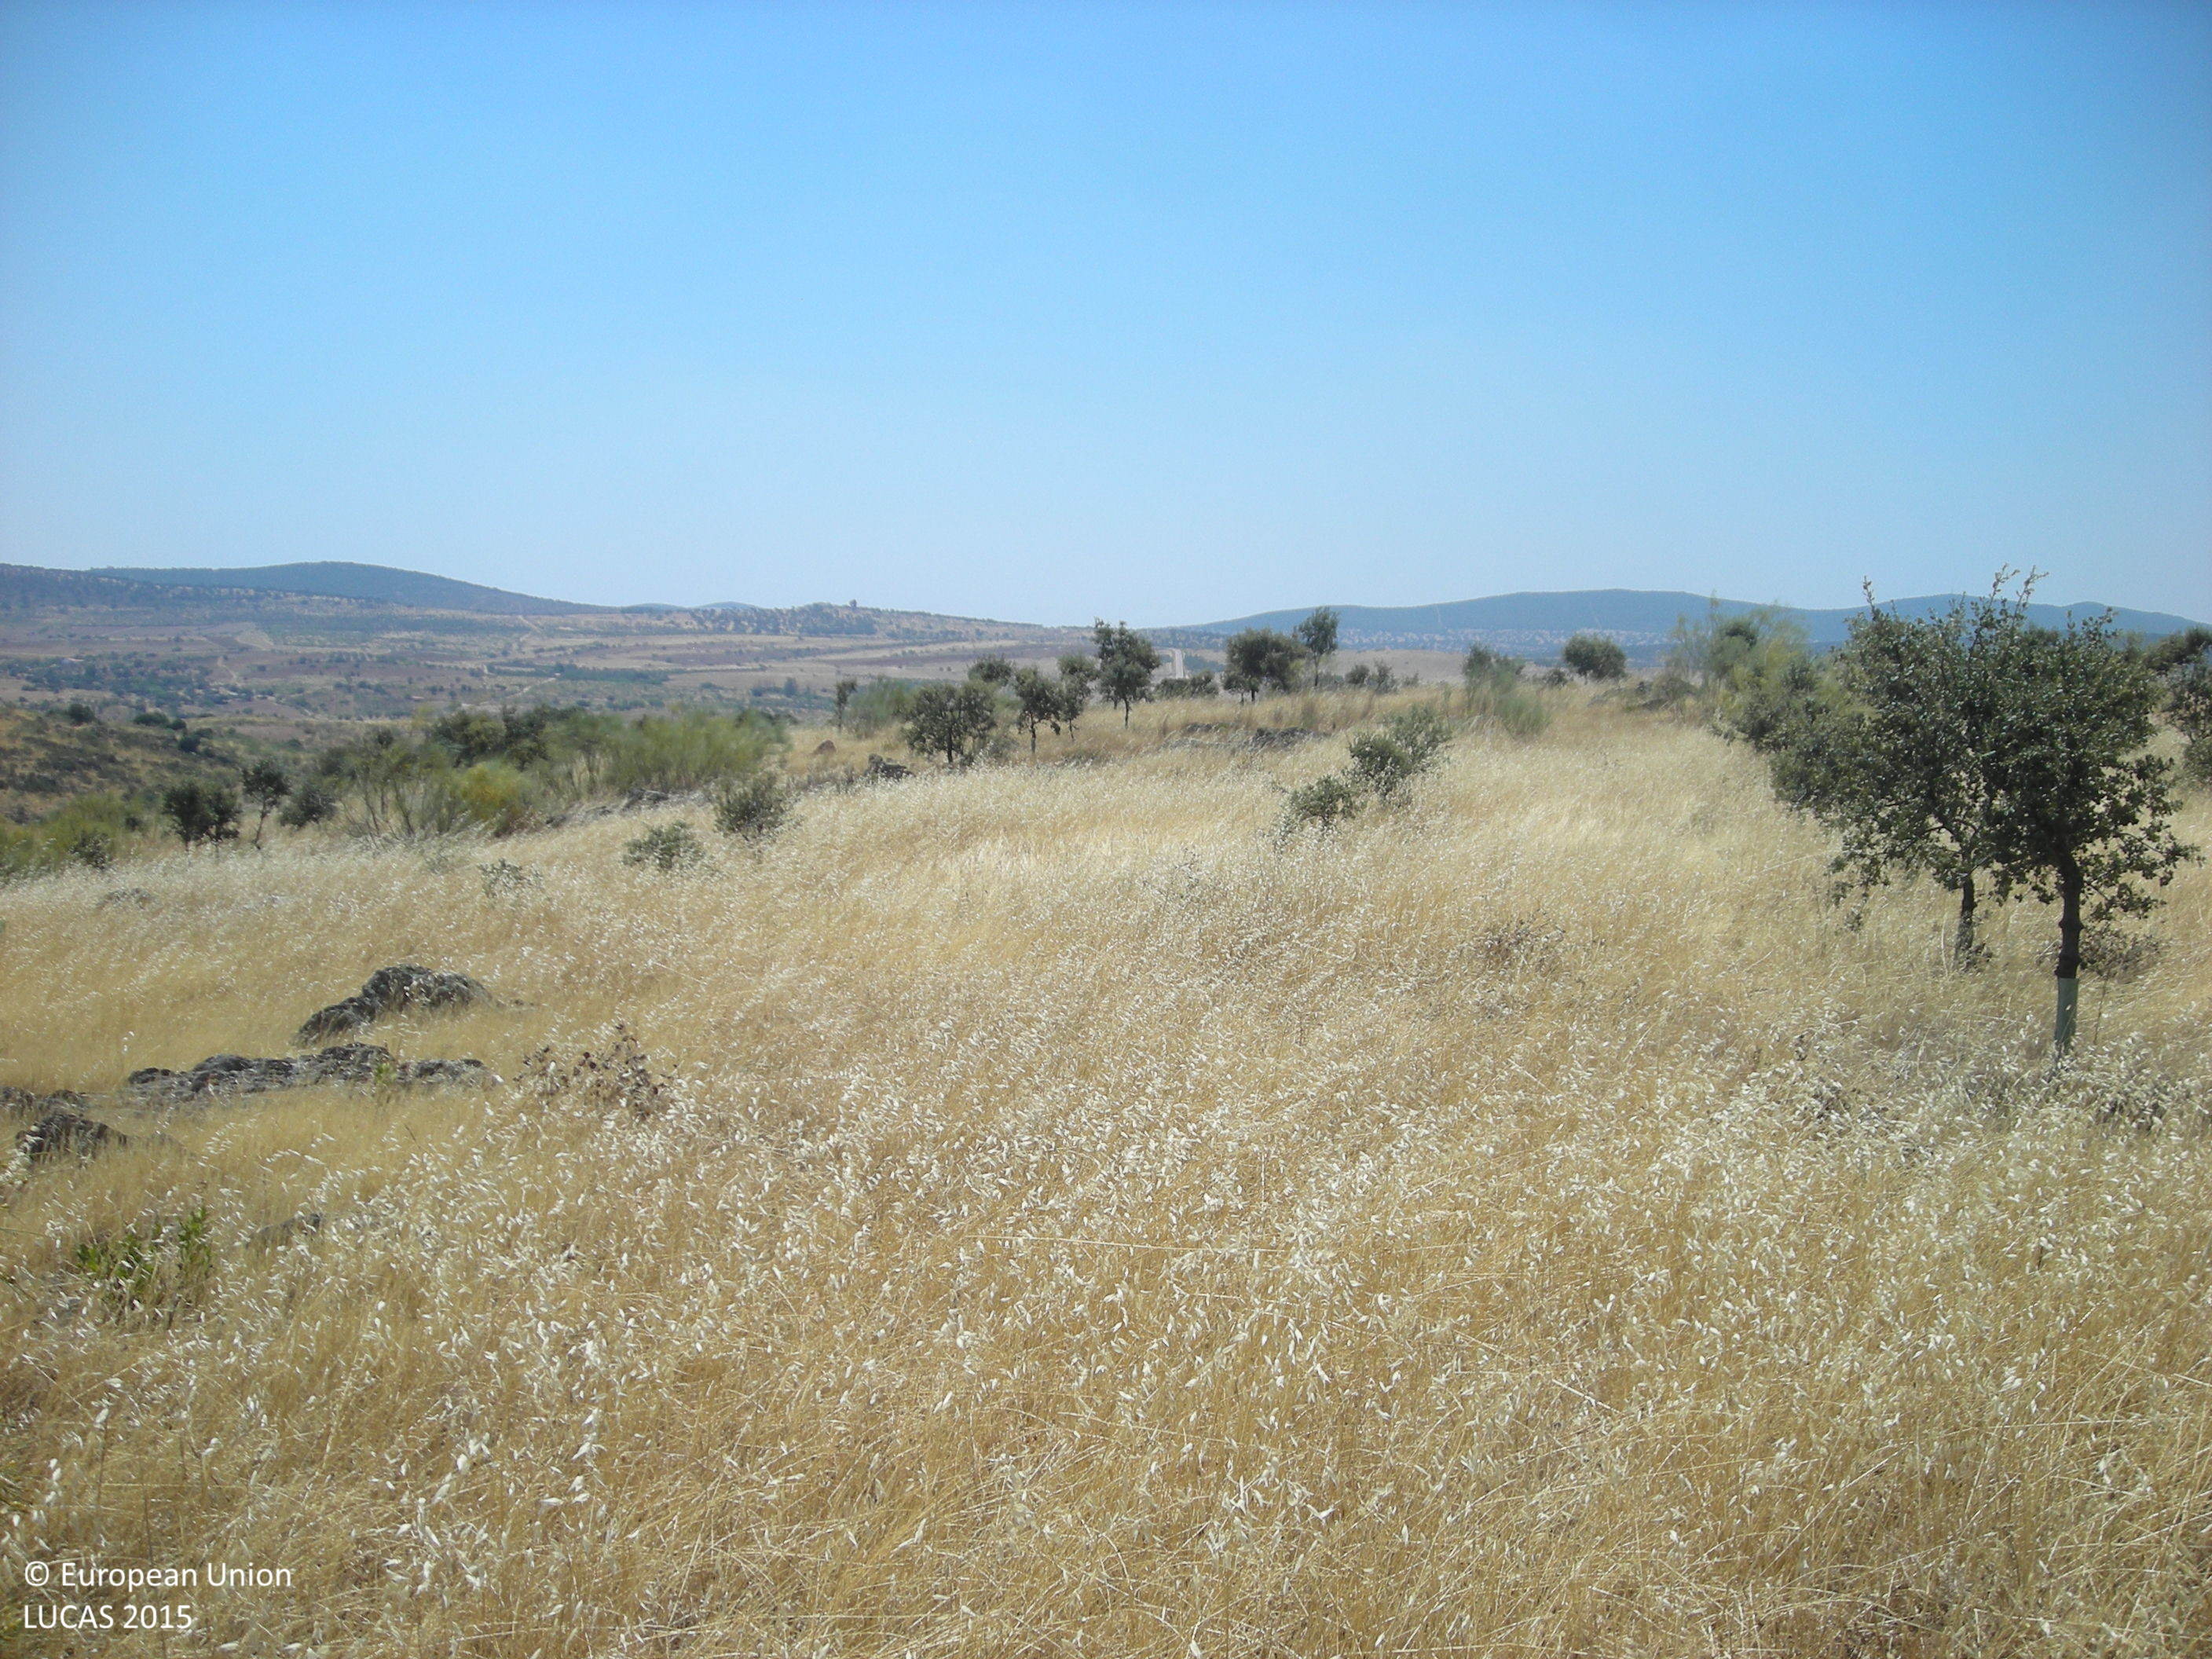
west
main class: Woodland
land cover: Broadleaved woodland
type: broadleaved evergreen forest
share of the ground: > 75 %
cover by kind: herbaceous plants 60 %, broadleaved forest trees 40 %
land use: Forestry
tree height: > 5 m
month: June
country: ES
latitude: 38.7005
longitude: -5.8083
